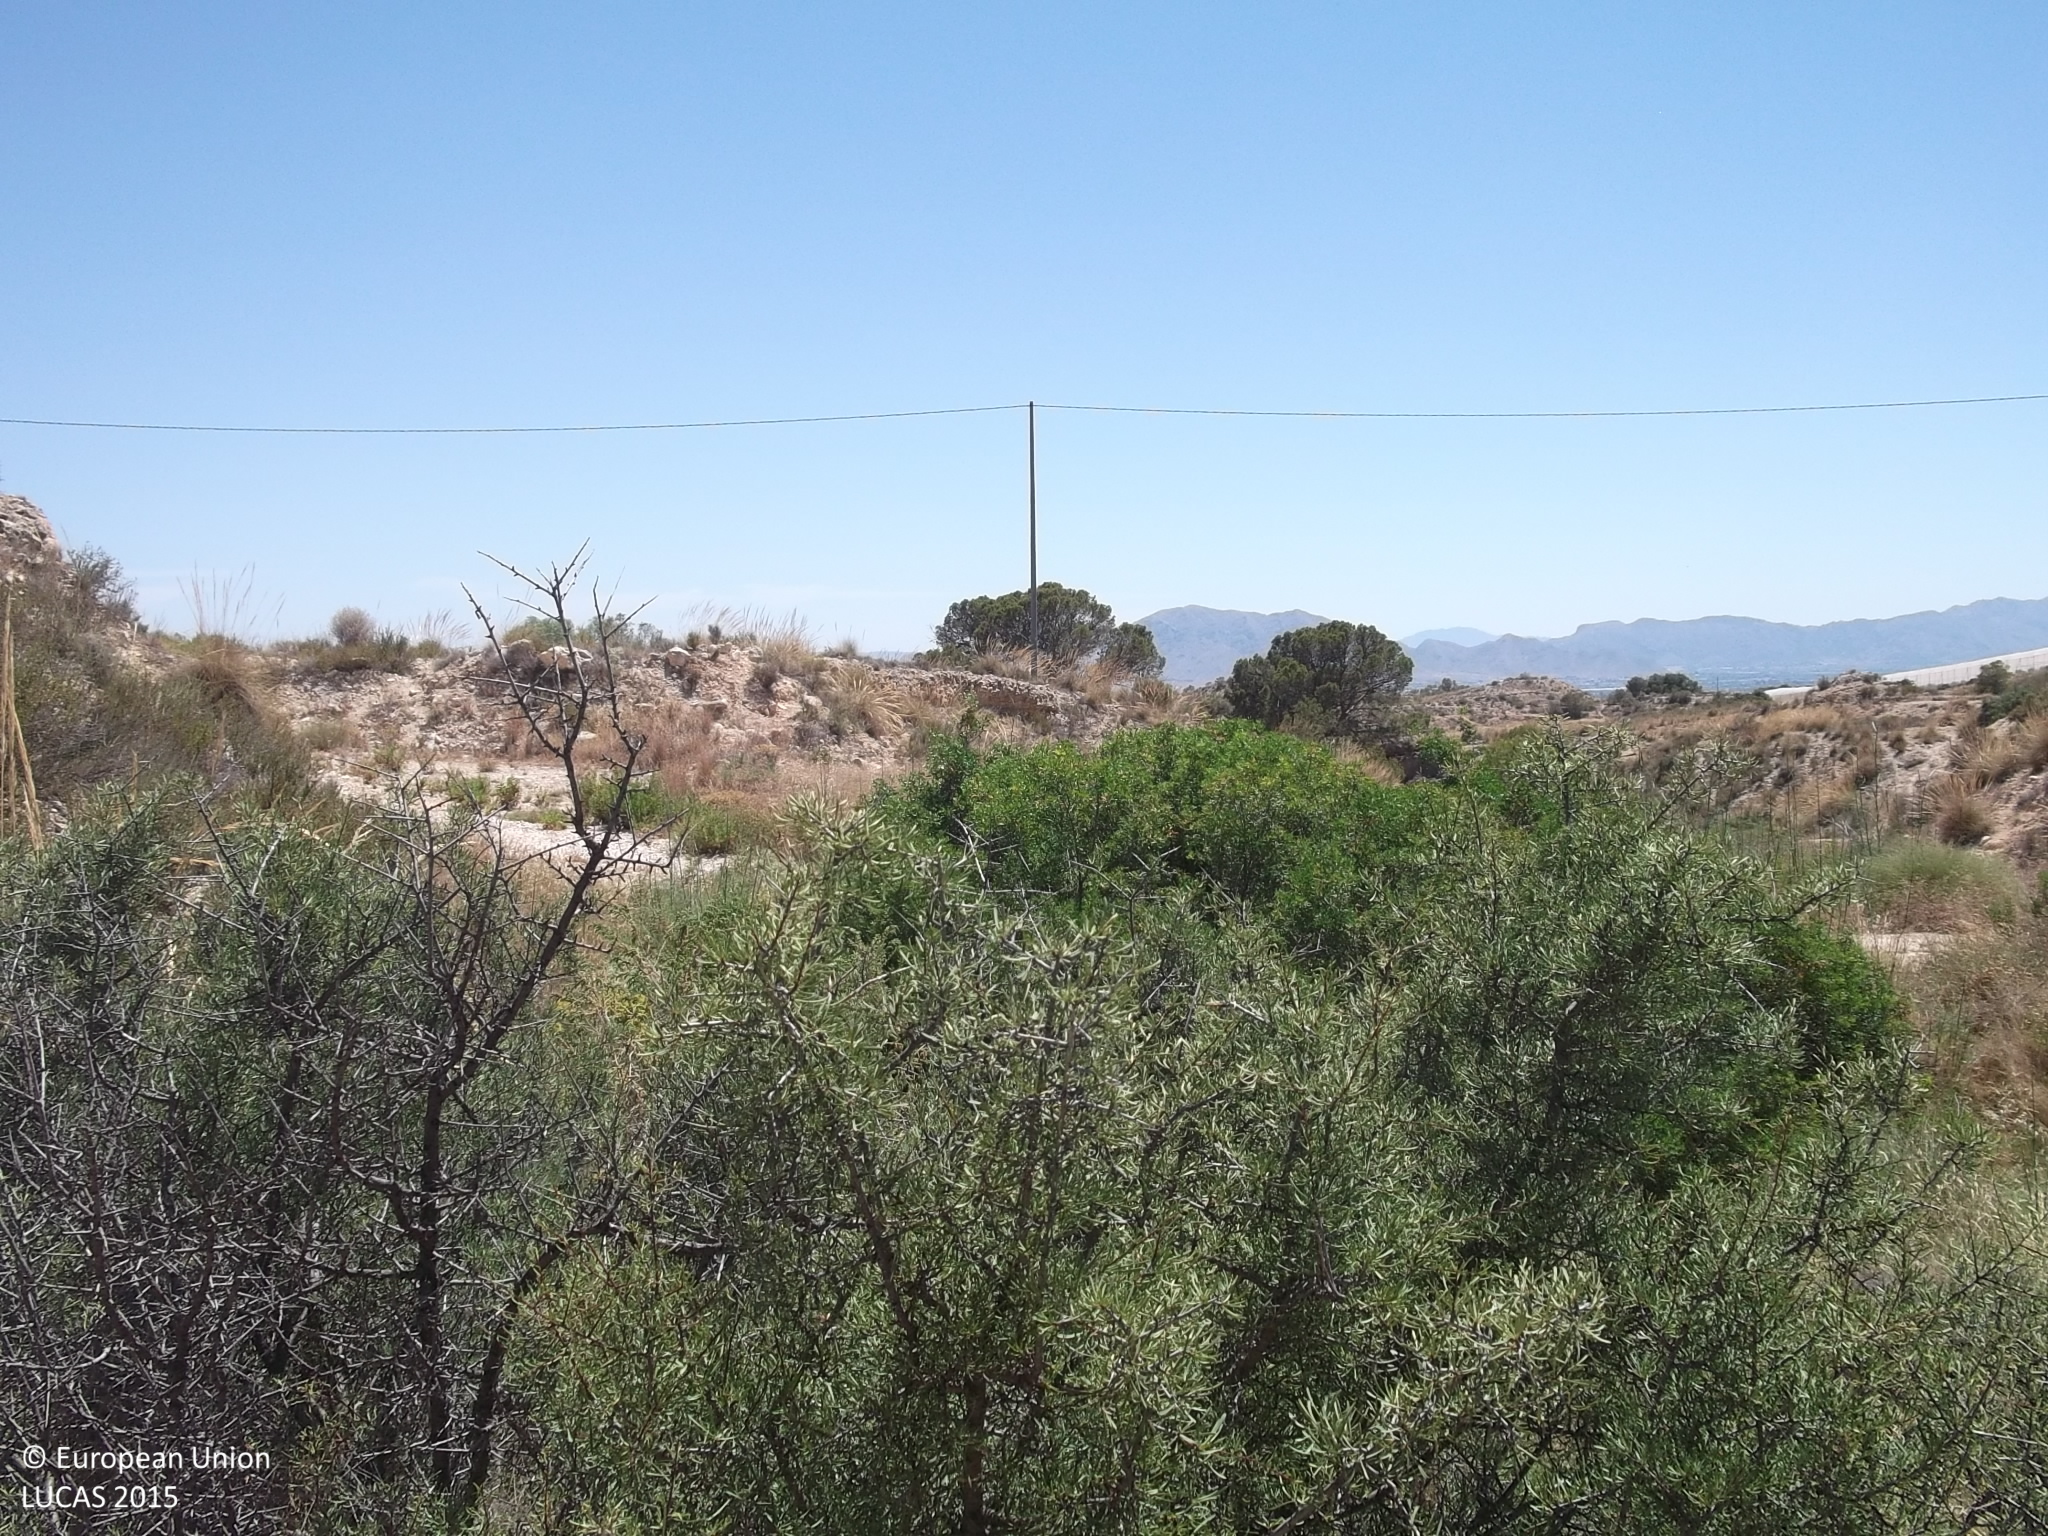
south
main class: Shrubland
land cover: Shrubland without tree cover
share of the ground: 25 - 50 %
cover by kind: herbaceous plants 40 %, shrubs 30 %, consolidated bare surface 30 %
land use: Abandoned areas
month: June
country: ES
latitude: 38.2576
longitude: -0.8540
